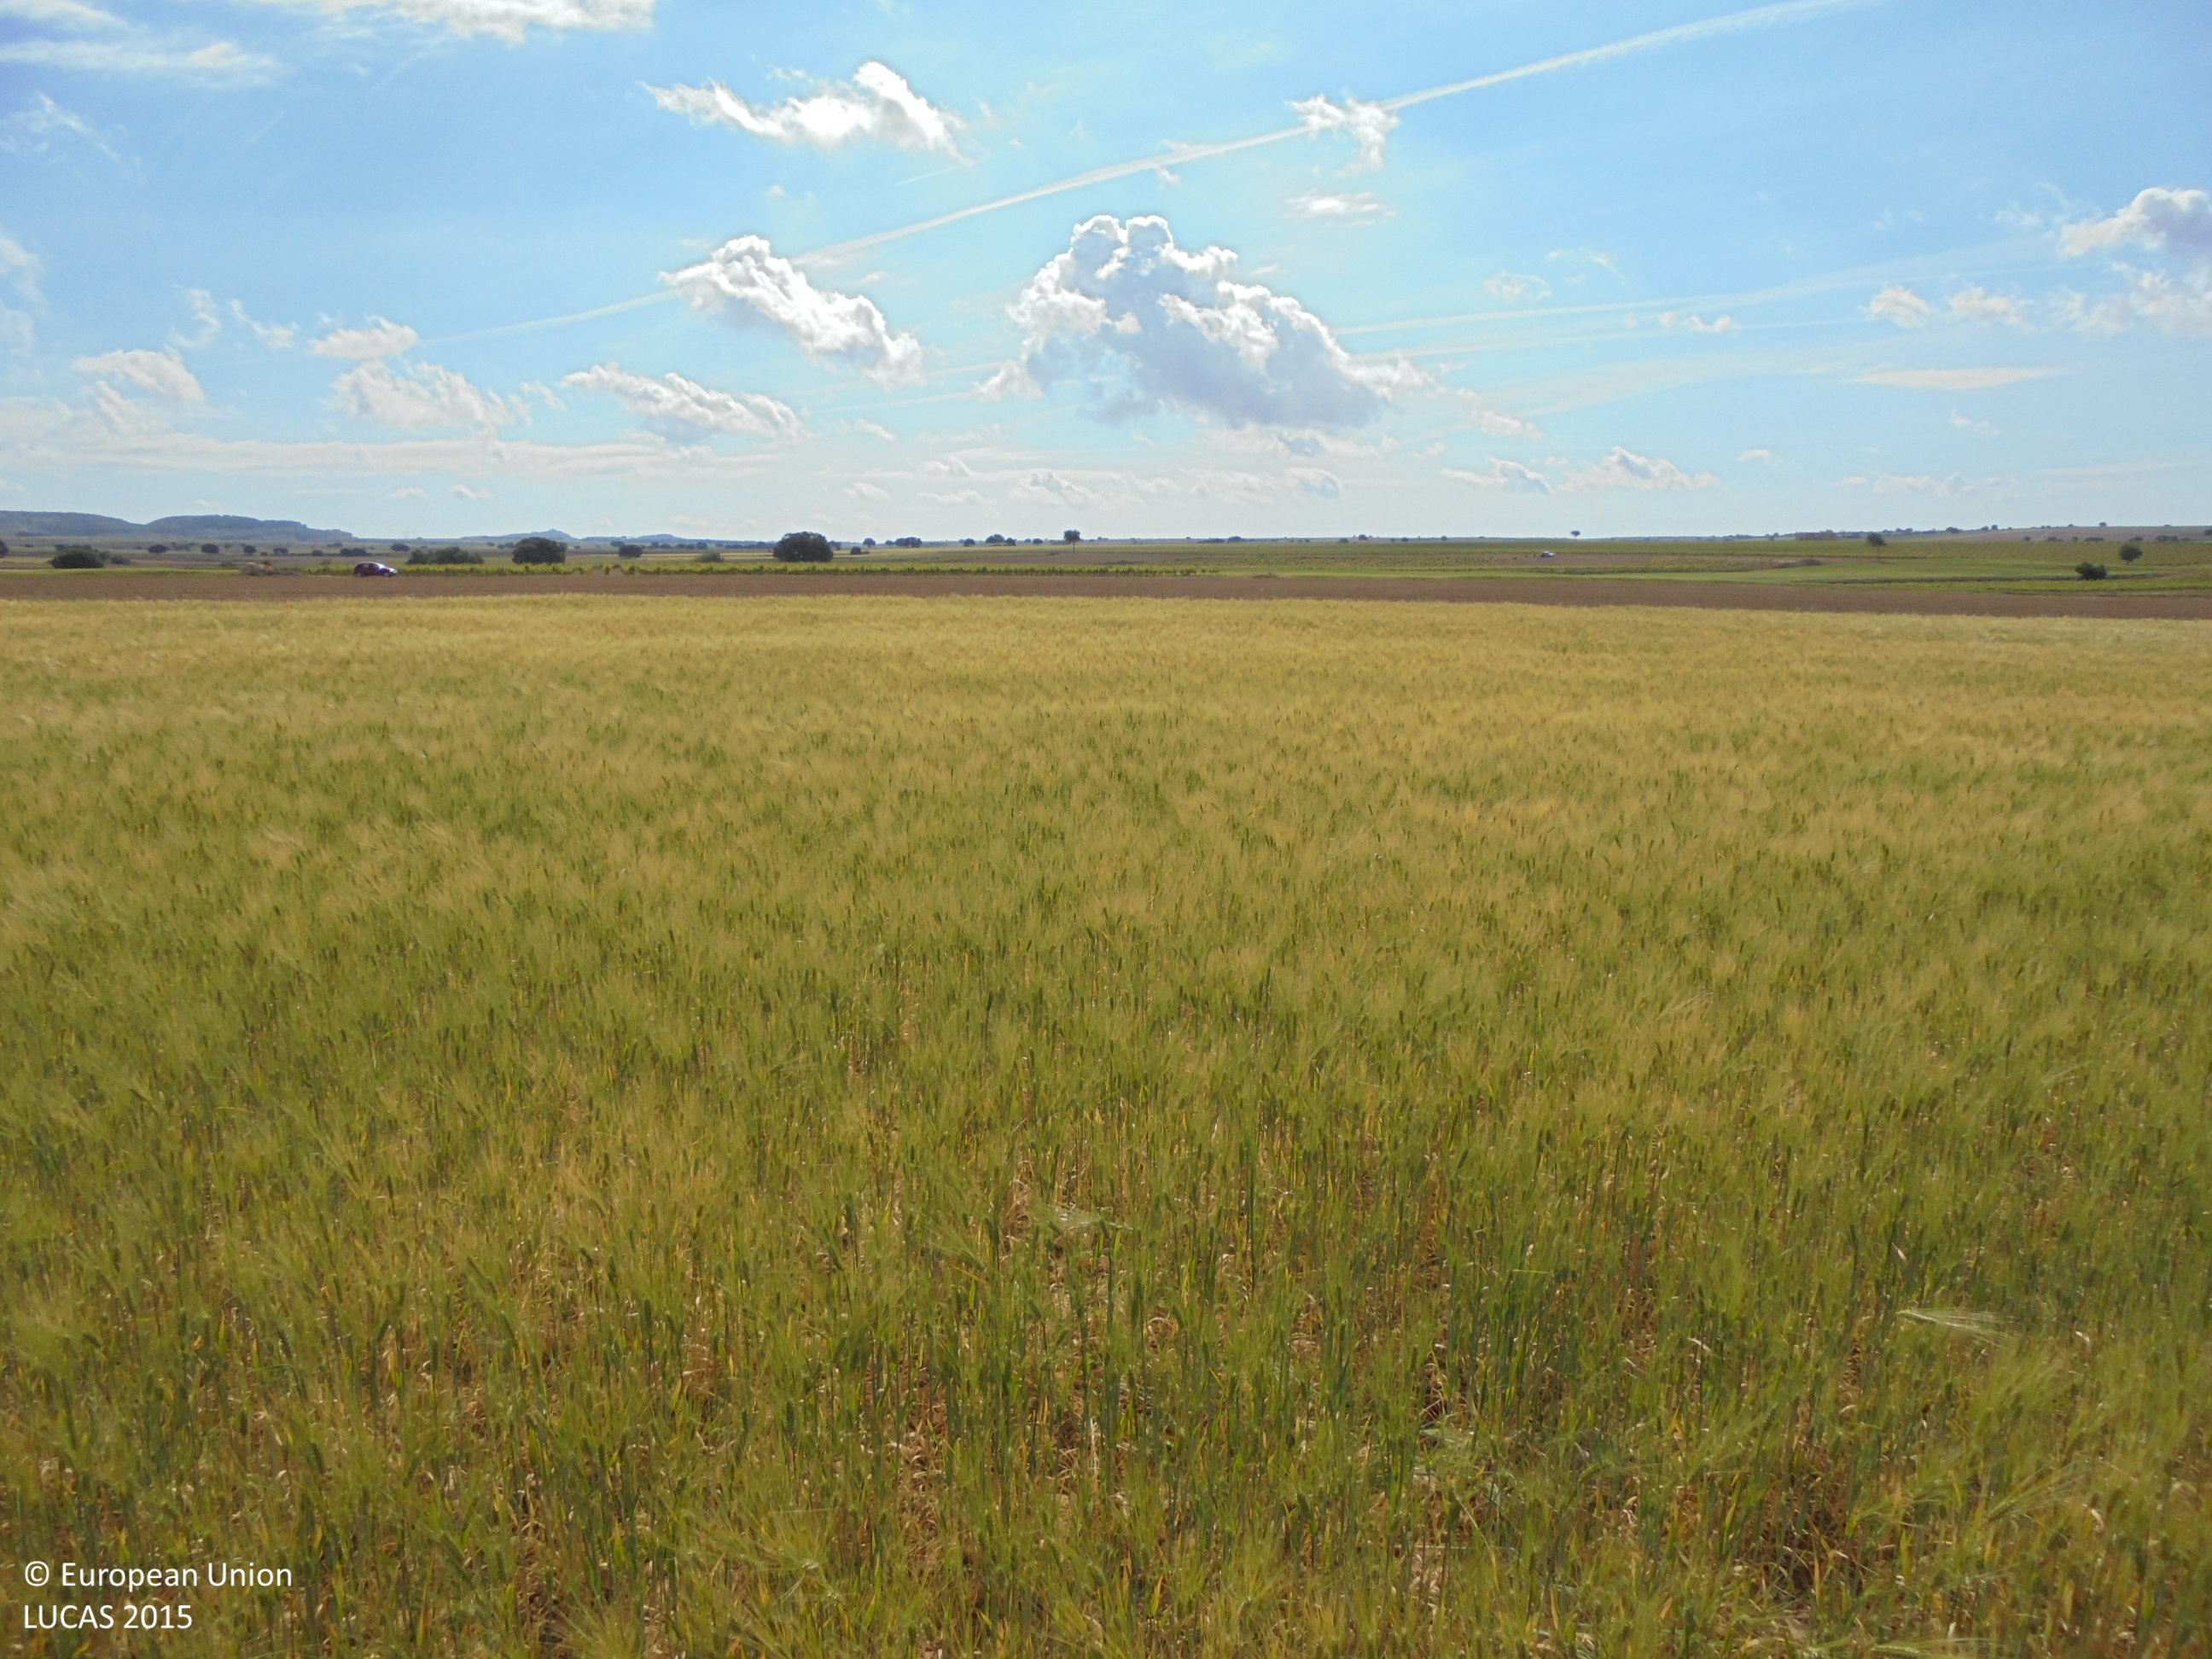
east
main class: Cropland
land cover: Barley
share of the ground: 25 - 50 %
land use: Agriculture (excluding fallow land and kitchen gardens)
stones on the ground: > 50 %
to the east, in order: Barley; Grass margins; Dry stone walls; Other bare soil; Grass margins; Tracks; Grass margins; Vineyards
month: May
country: ES
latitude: 38.9492
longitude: -1.5013
